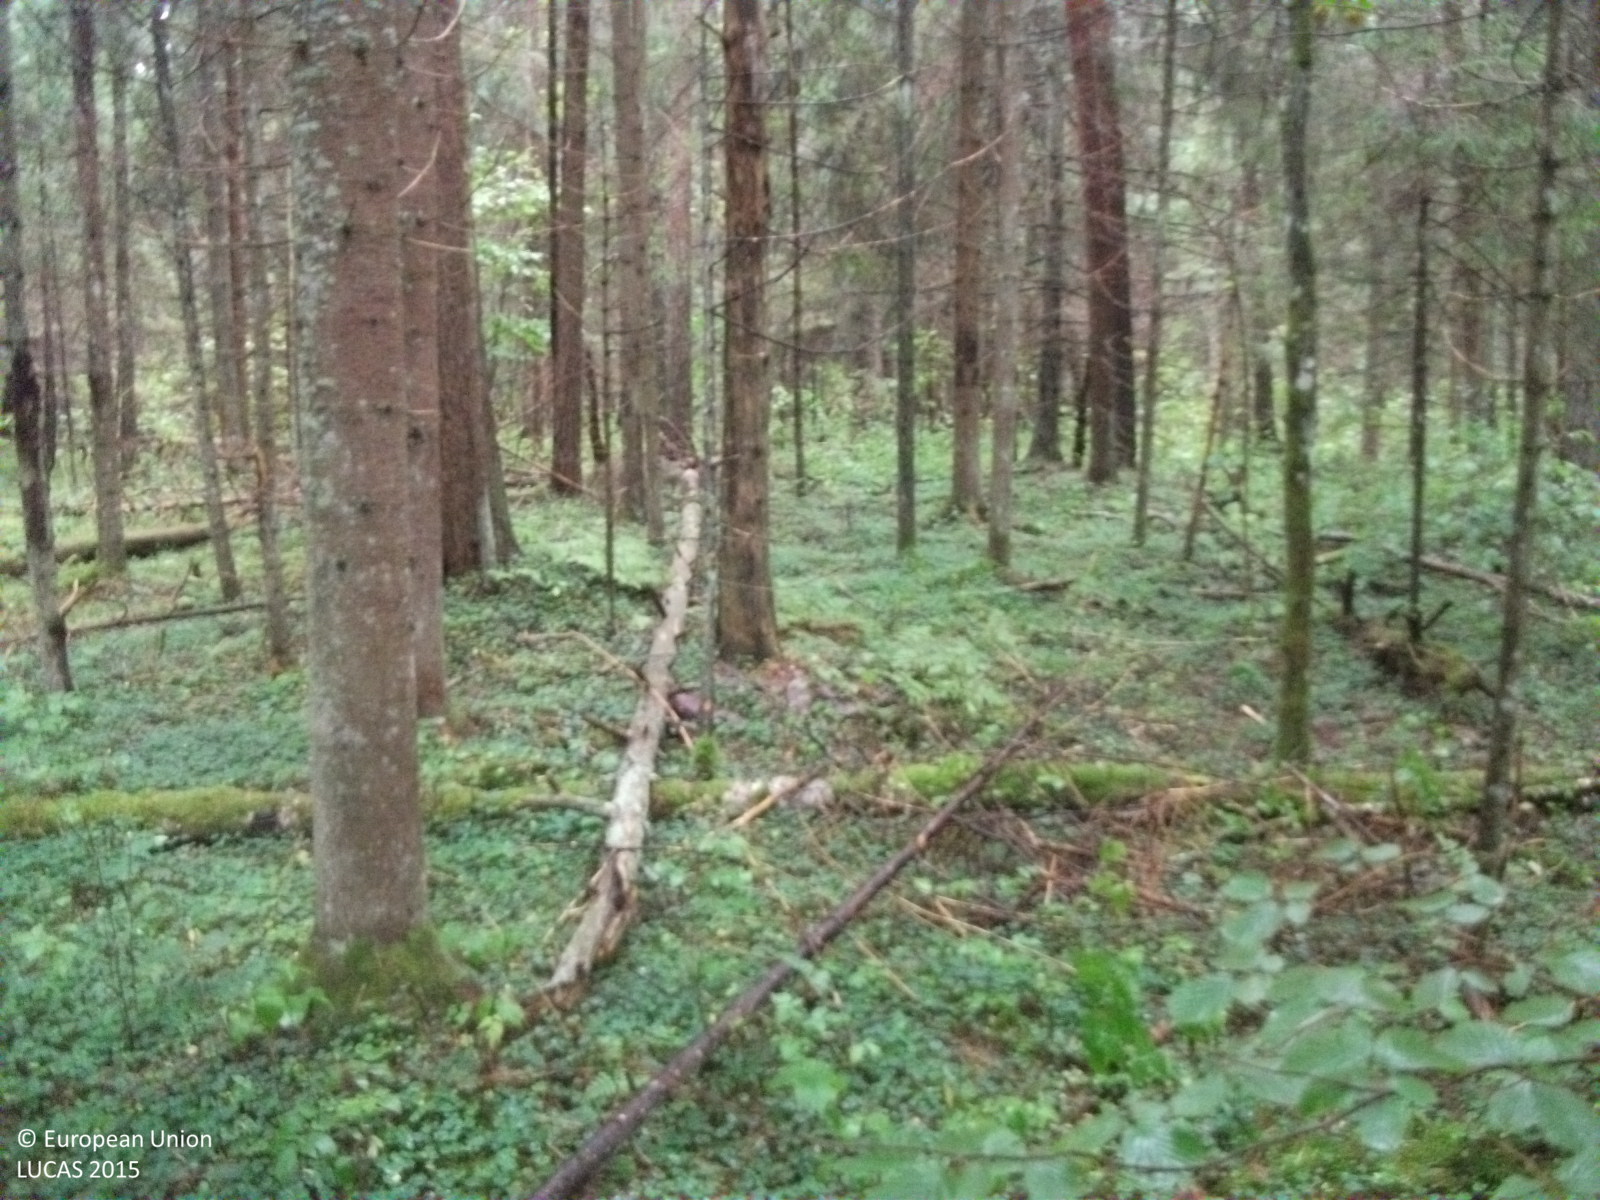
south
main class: Woodland
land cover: Spruce dominated coniferous woodland
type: hemiboreal forest and nemoral coniferous forest and mixed broadleaved-coniferous forest
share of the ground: > 75 %
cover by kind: coniferous forest trees 80 %, broadleaved forest trees 10 %, shrubs 5 %, herbaceous plants 5 %
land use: Forestry
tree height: > 5 m
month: September
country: LV
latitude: 57.5984
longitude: 24.7709
